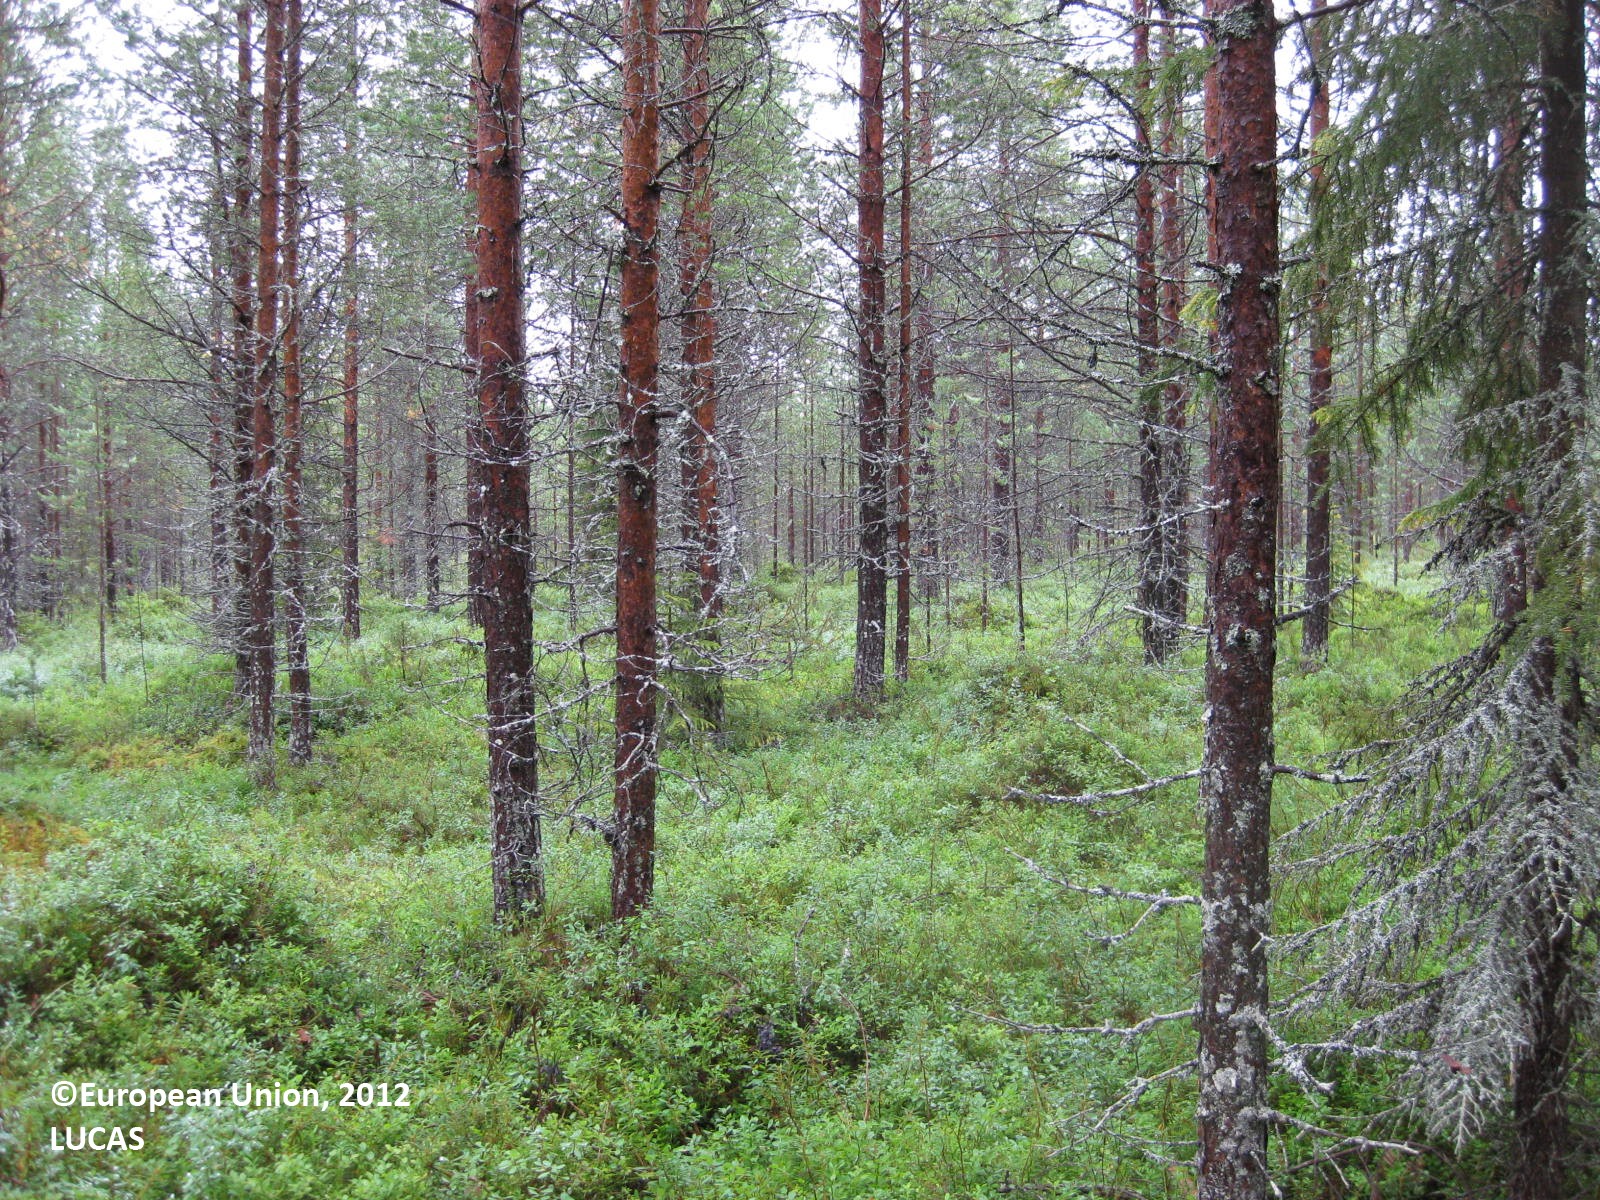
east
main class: Woodland
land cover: Pine dominated coniferous woodland
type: boreal forest
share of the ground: 50 - 75 %
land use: Forestry
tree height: > 5 m
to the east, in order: Pine dominated coniferous woodland
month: August
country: FI
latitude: 65.9885
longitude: 28.3172
